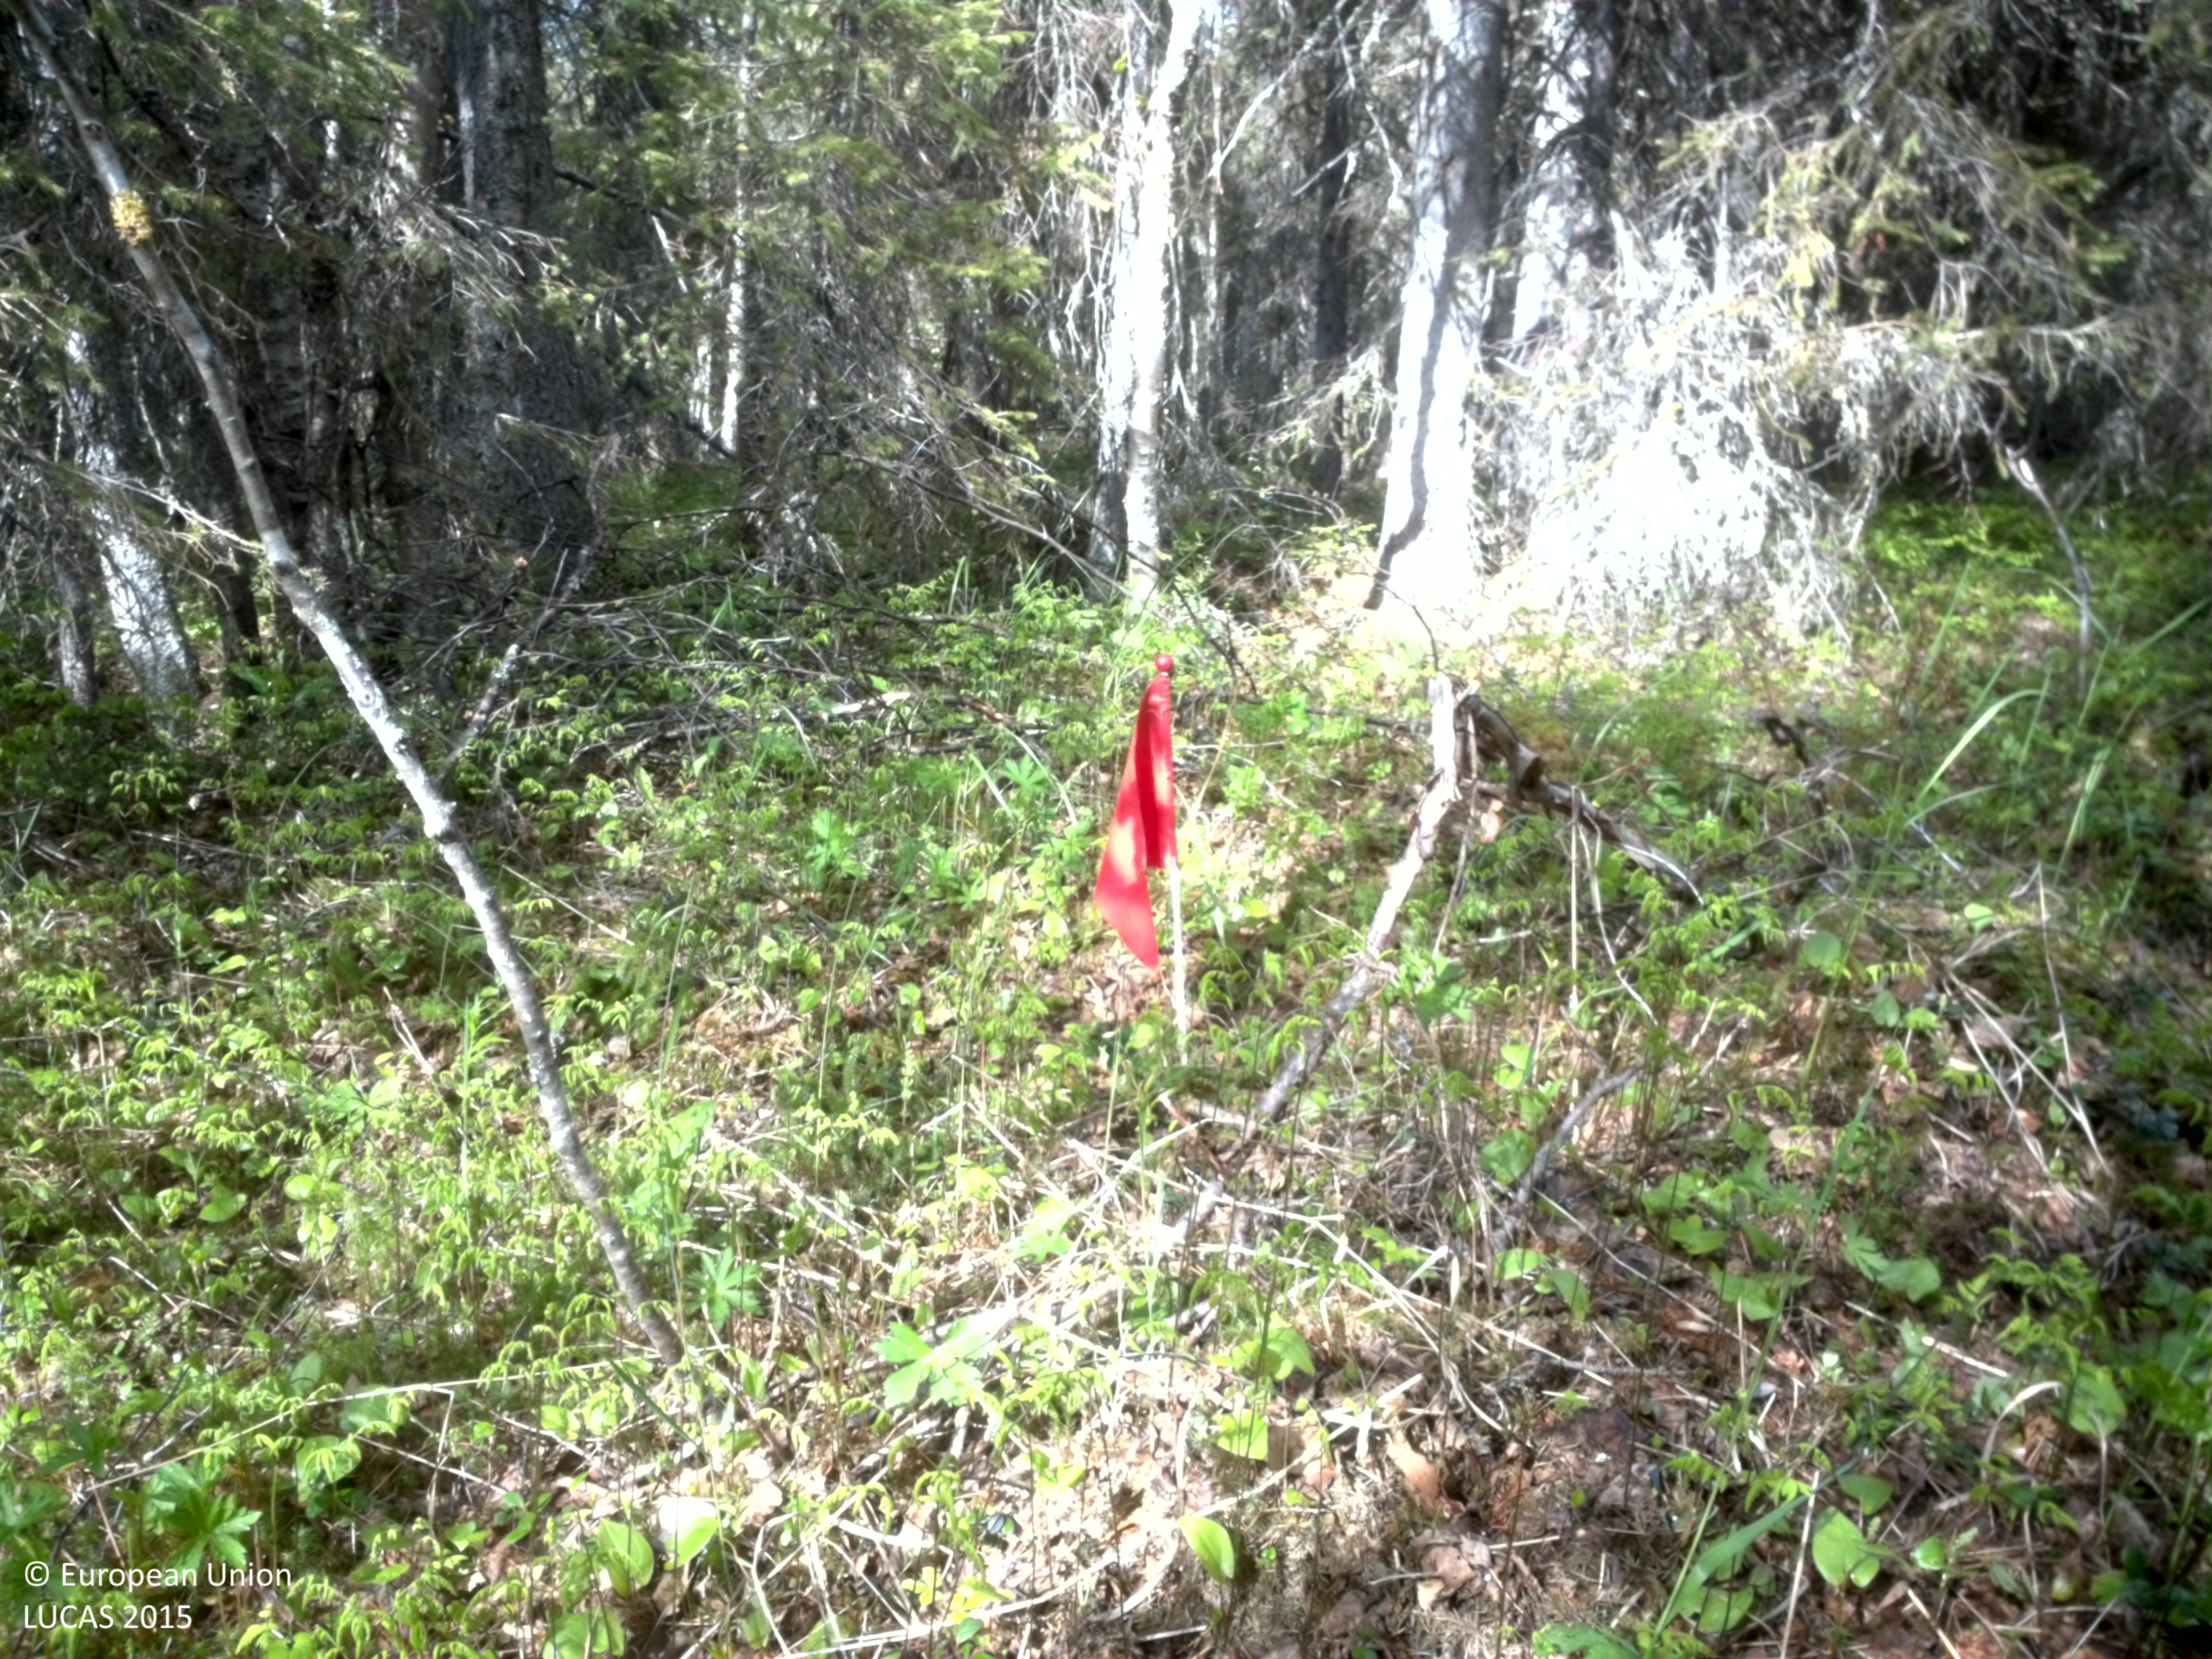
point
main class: Woodland
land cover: Spruce dominated mixed woodland
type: boreal forest
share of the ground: 50 - 75 %
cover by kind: coniferous forest trees 35 %, herbaceous plants 35 %, broadleaved forest trees 20 %, shrubs 5 %, lichens and mosses 5 %
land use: Forestry
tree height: > 5 m
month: June
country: SE
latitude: 67.0002
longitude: 22.0472
